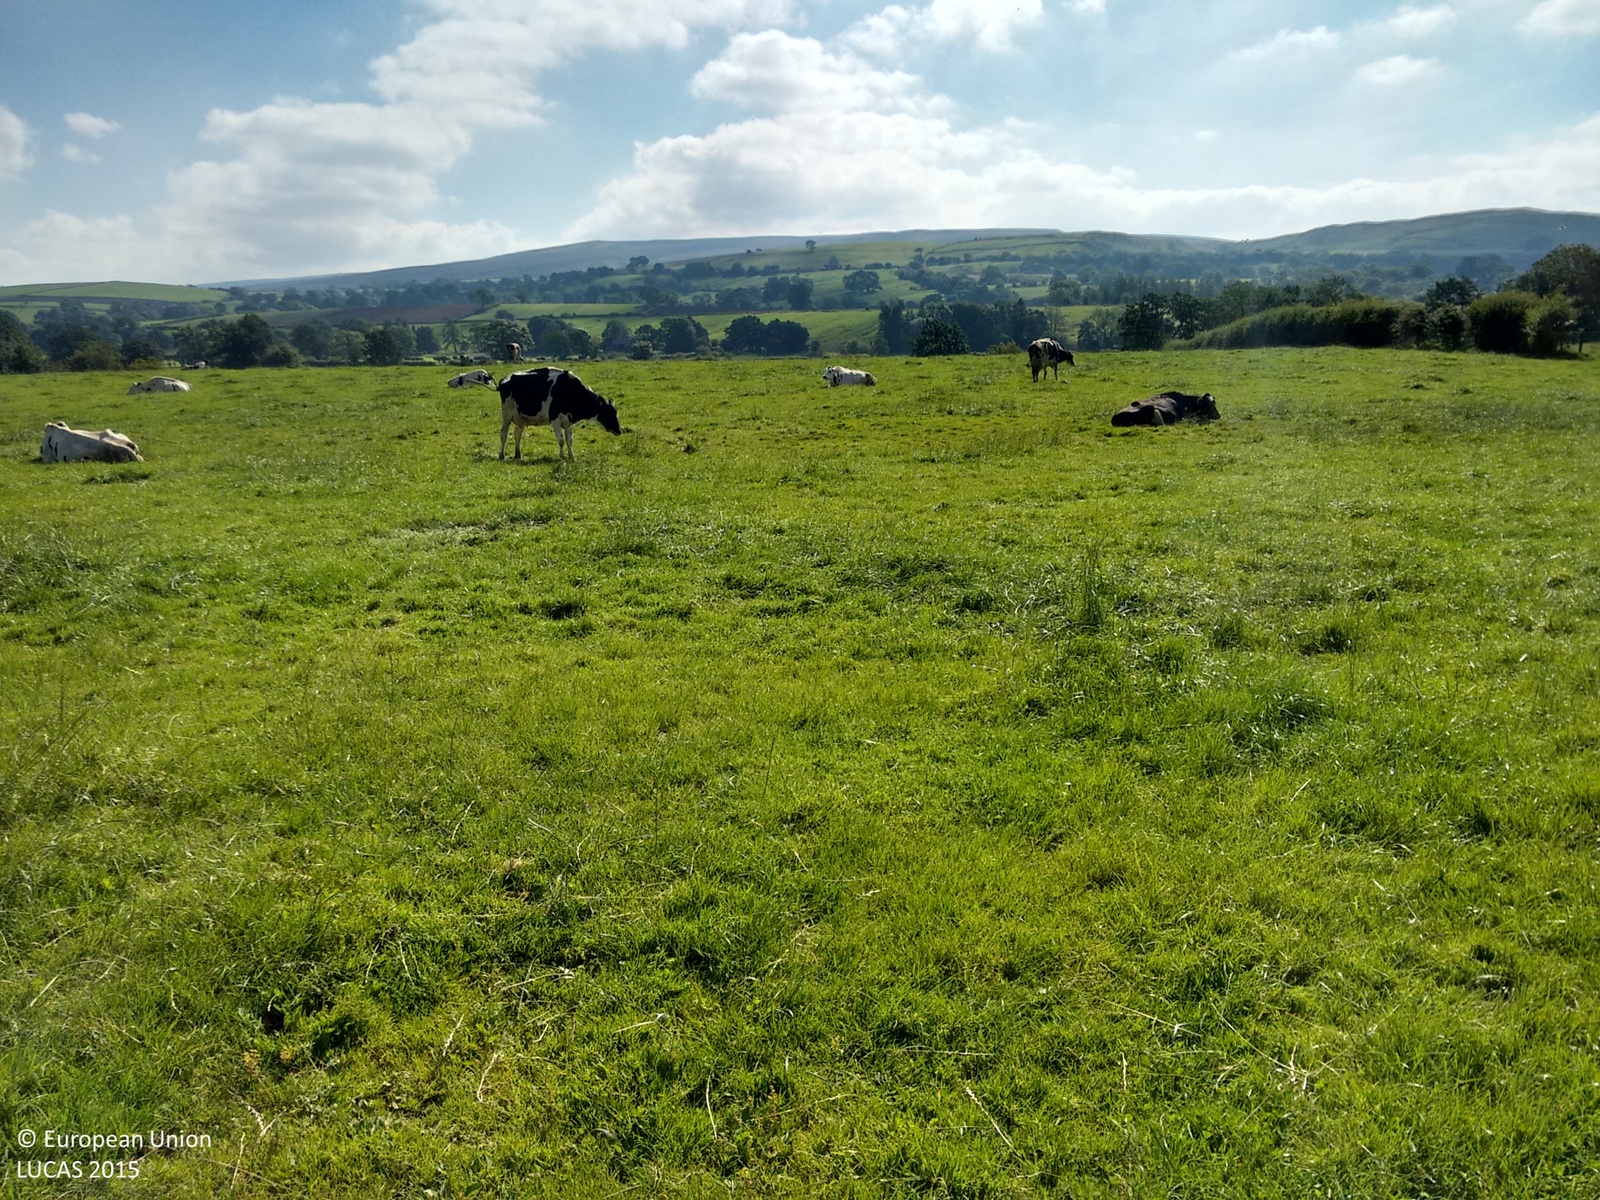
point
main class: Grassland
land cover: Grassland without tree/shrub cover
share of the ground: > 75 %
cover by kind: herbaceous plants 100 %
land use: Agriculture (excluding fallow land and kitchen gardens)
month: September
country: GB
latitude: 54.5003
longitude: -2.3057
